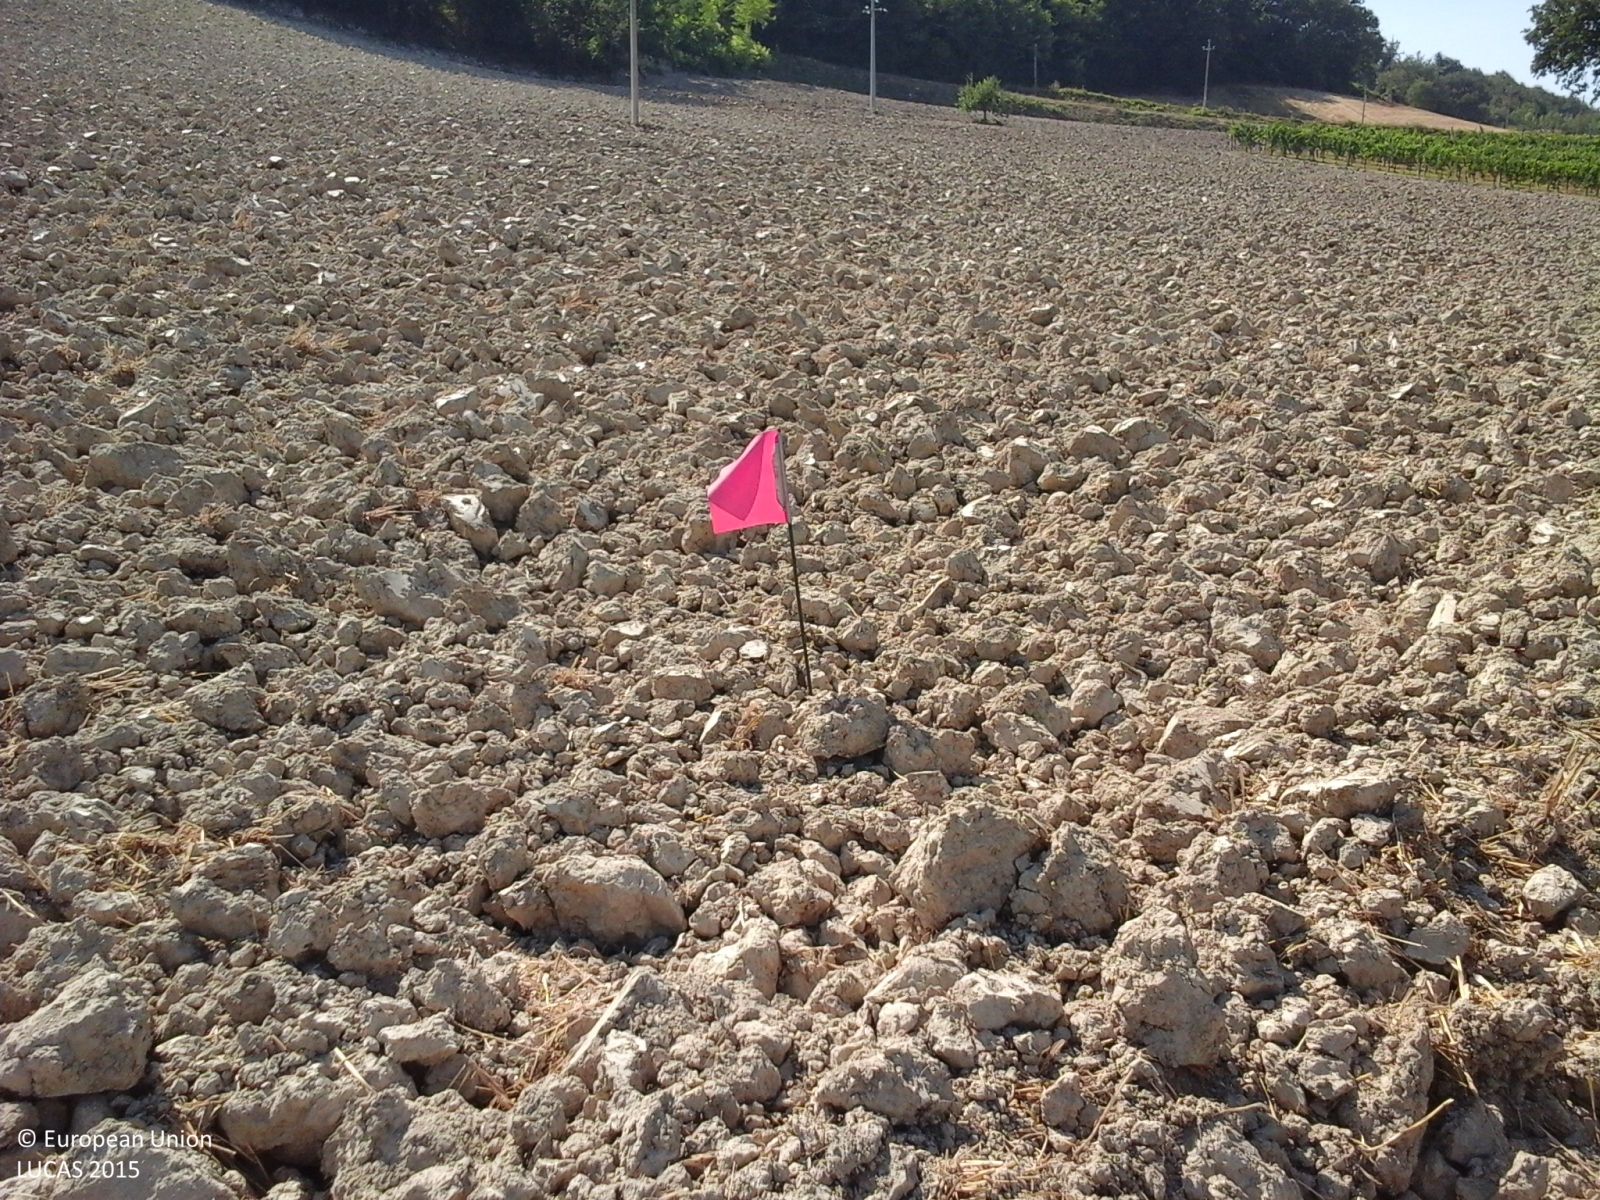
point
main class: Cropland
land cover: Common wheat
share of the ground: > 75 %
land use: Agriculture (excluding fallow land and kitchen gardens)
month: August
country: IT
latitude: 43.6680
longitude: 12.6103
